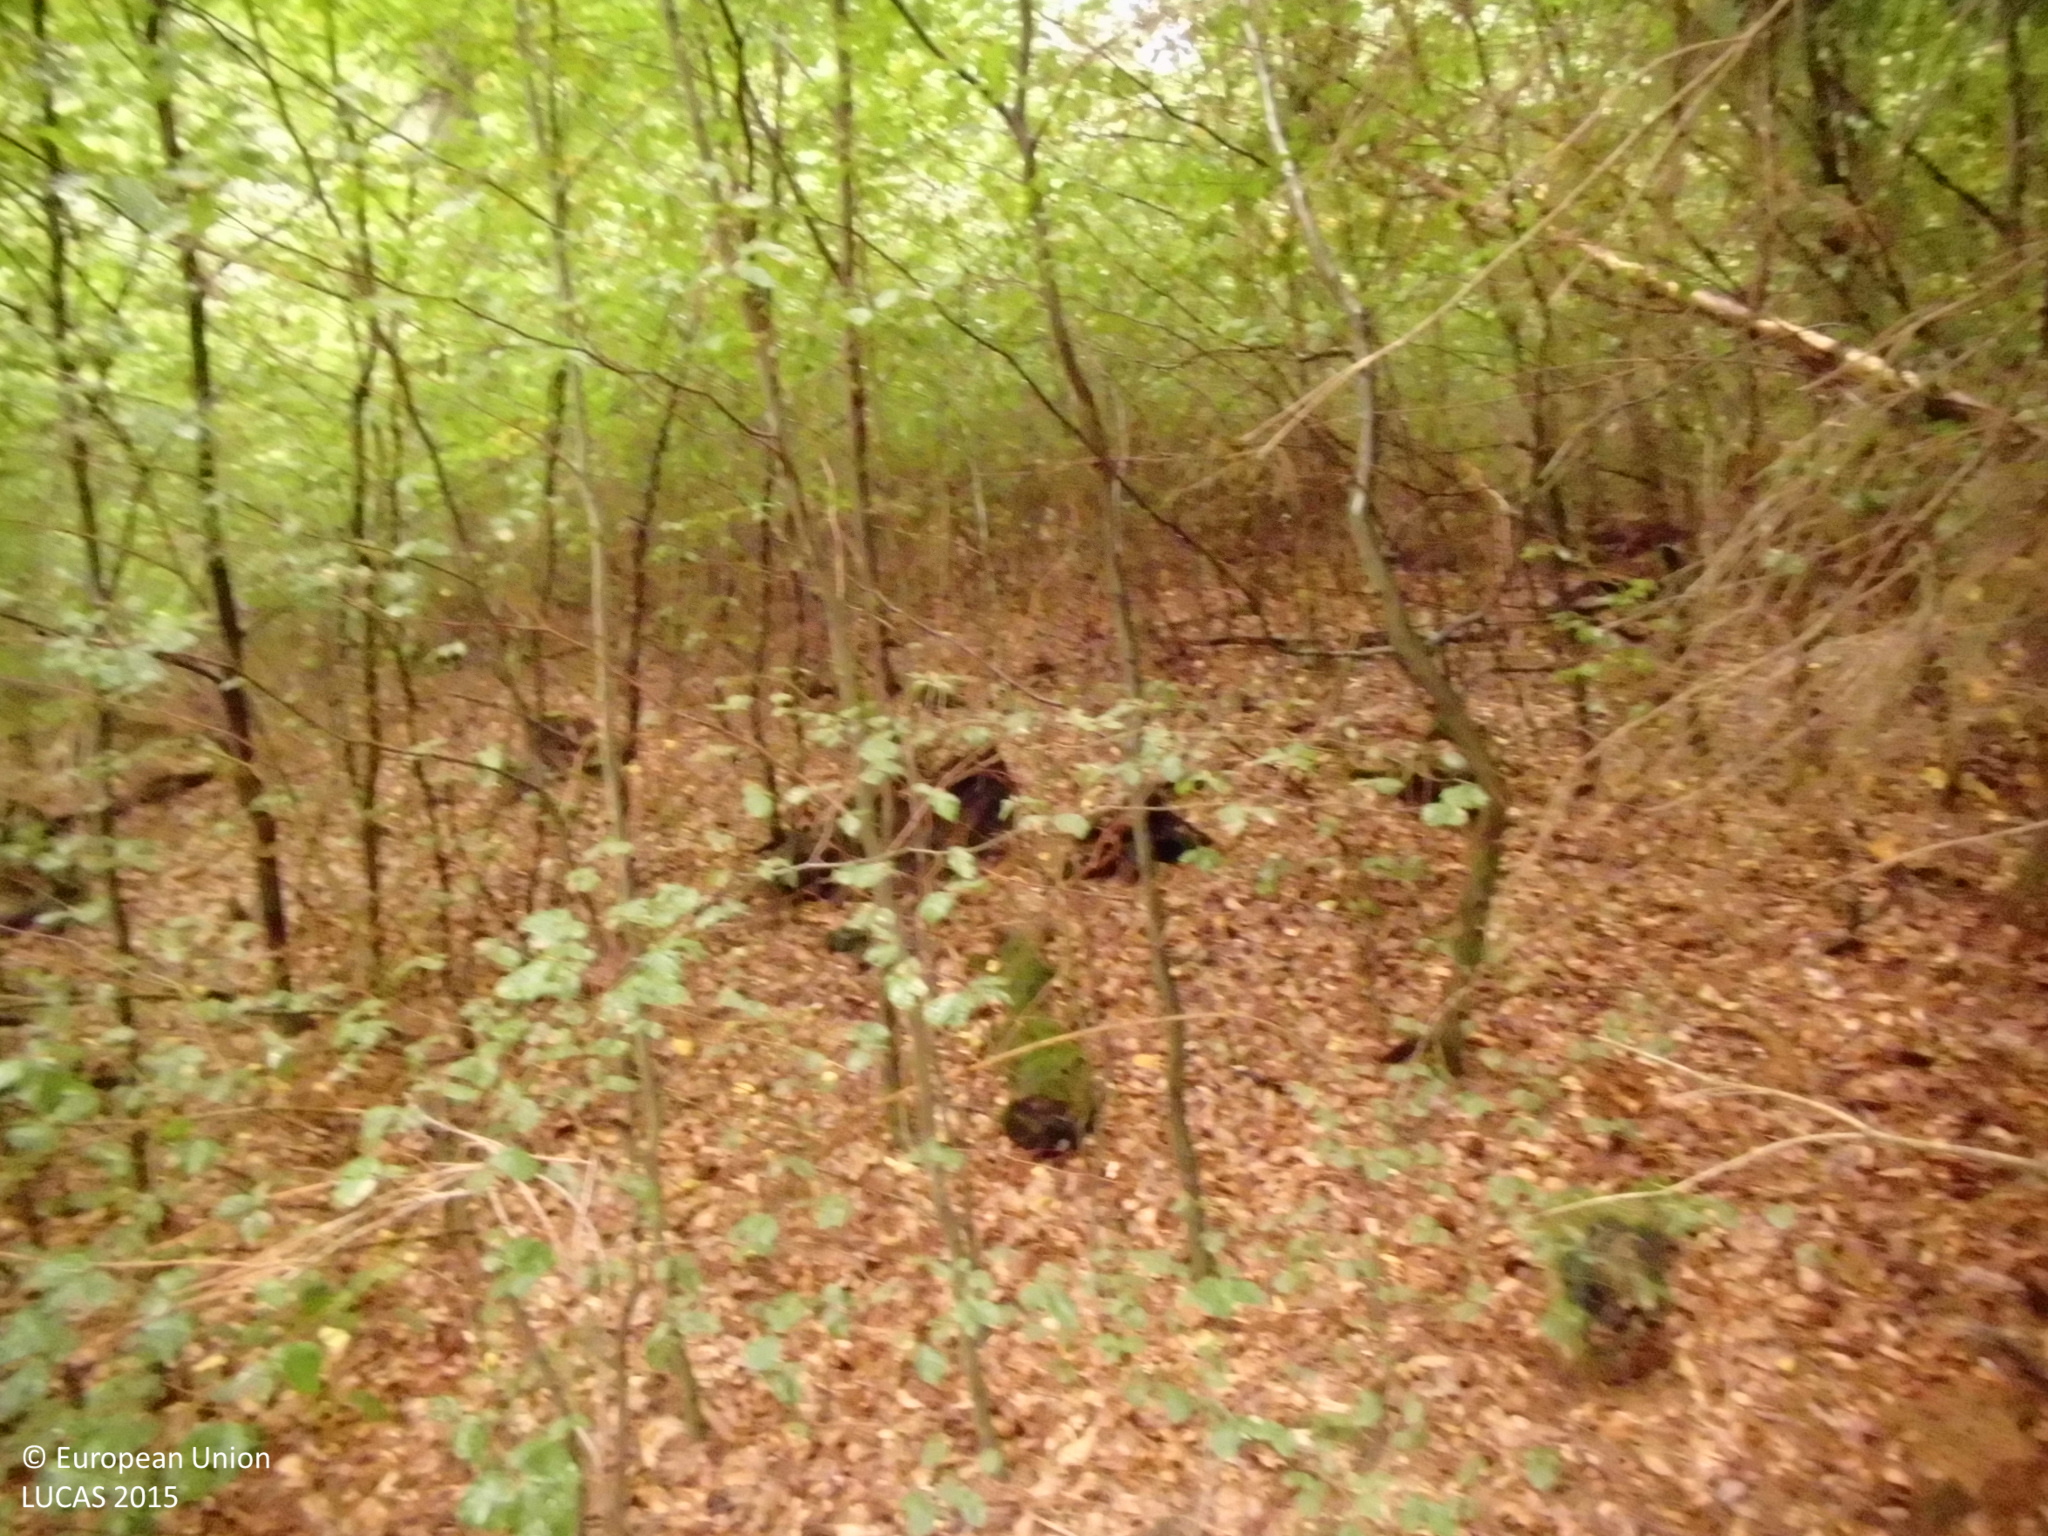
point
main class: Woodland
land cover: Broadleaved woodland
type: mesophytic deciduous forest
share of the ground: > 75 %
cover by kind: broadleaved forest trees 100 %
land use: Forestry
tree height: > 5 m
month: September
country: DE
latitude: 50.6239
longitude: 7.4700
